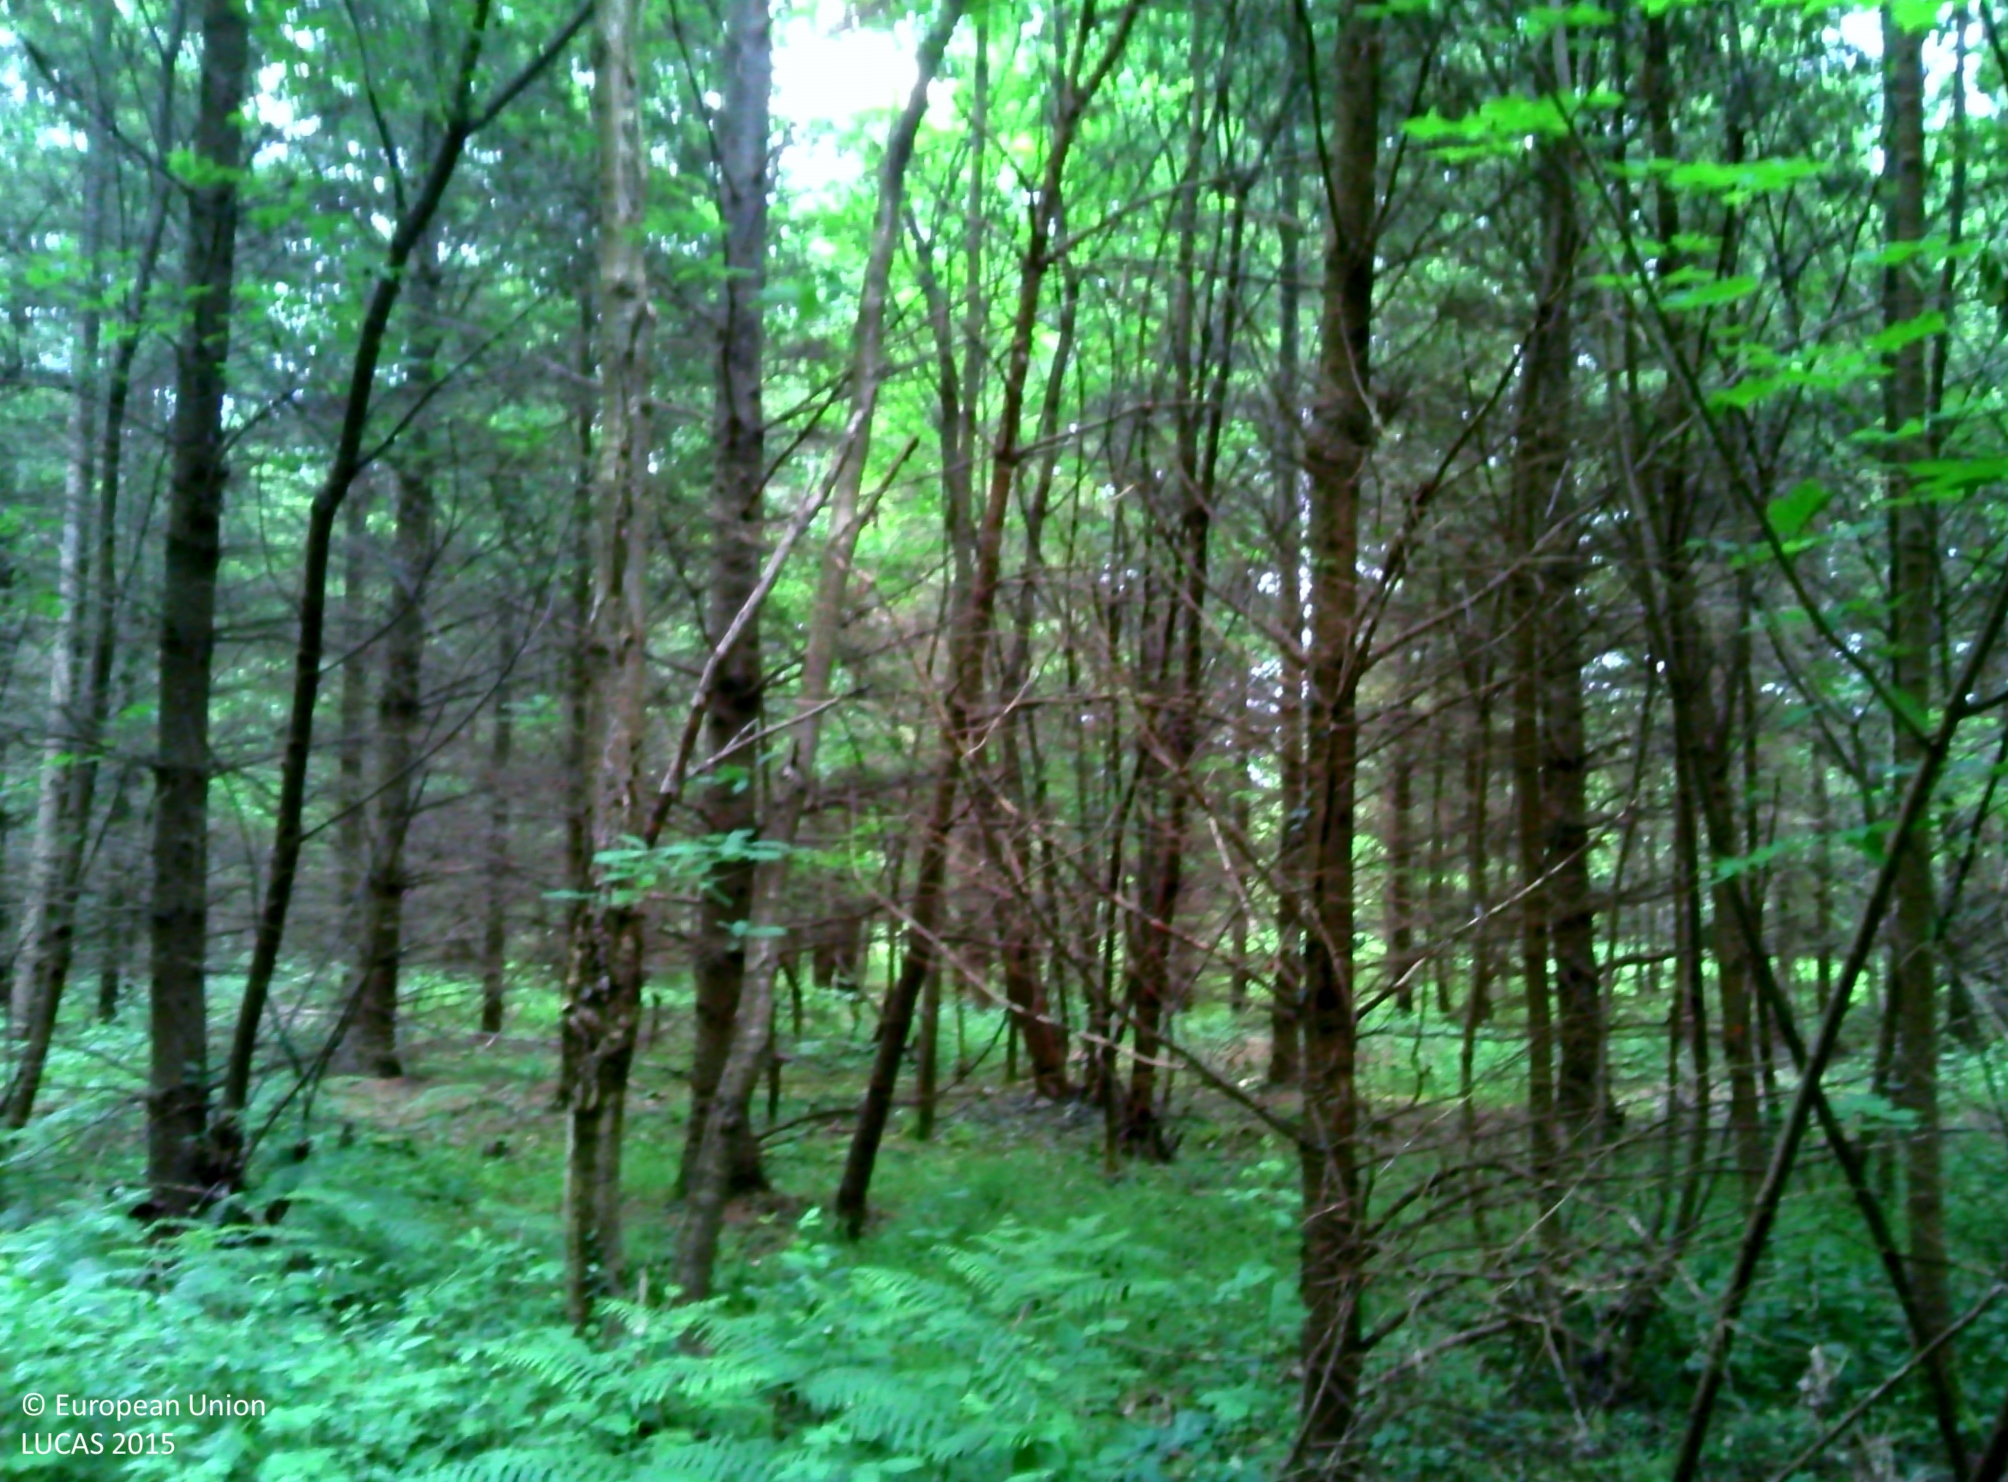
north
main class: Woodland
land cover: Spruce dominated mixed woodland
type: hemiboreal forest and nemoral coniferous forest and mixed broadleaved-coniferous forest
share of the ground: > 75 %
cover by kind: coniferous forest trees 55 %, broadleaved forest trees 30 %, shrubs 5 %, herbaceous plants 5 %, lichens and mosses 5 %
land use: Forestry
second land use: Sport
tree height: > 5 m
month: June
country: FR
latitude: 49.3813
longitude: 2.8409
